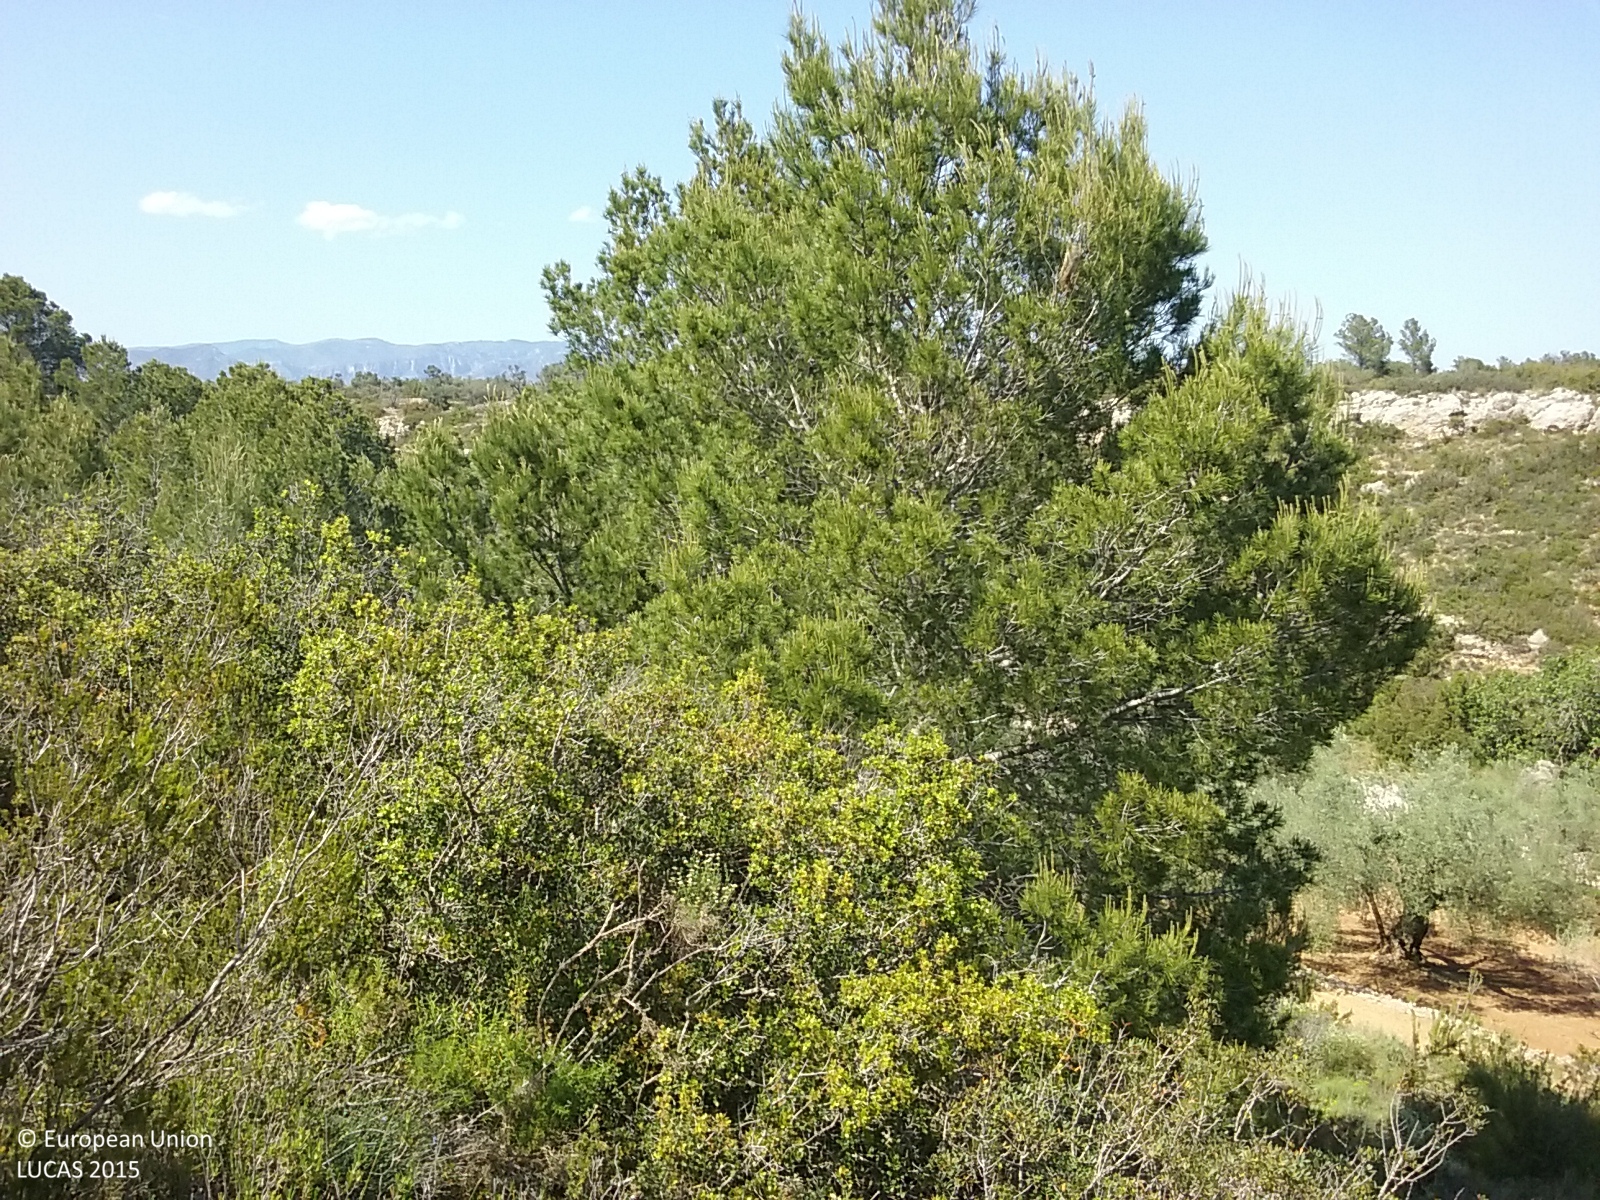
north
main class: Shrubland
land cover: Shrubland with sparse tree cover
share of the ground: > 75 %
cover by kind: shrubs 85 %, coniferous forest trees 5 %
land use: Semi-natural and natural areas not in use
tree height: > 5 m
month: May
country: ES
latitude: 40.5862
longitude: 0.2948
